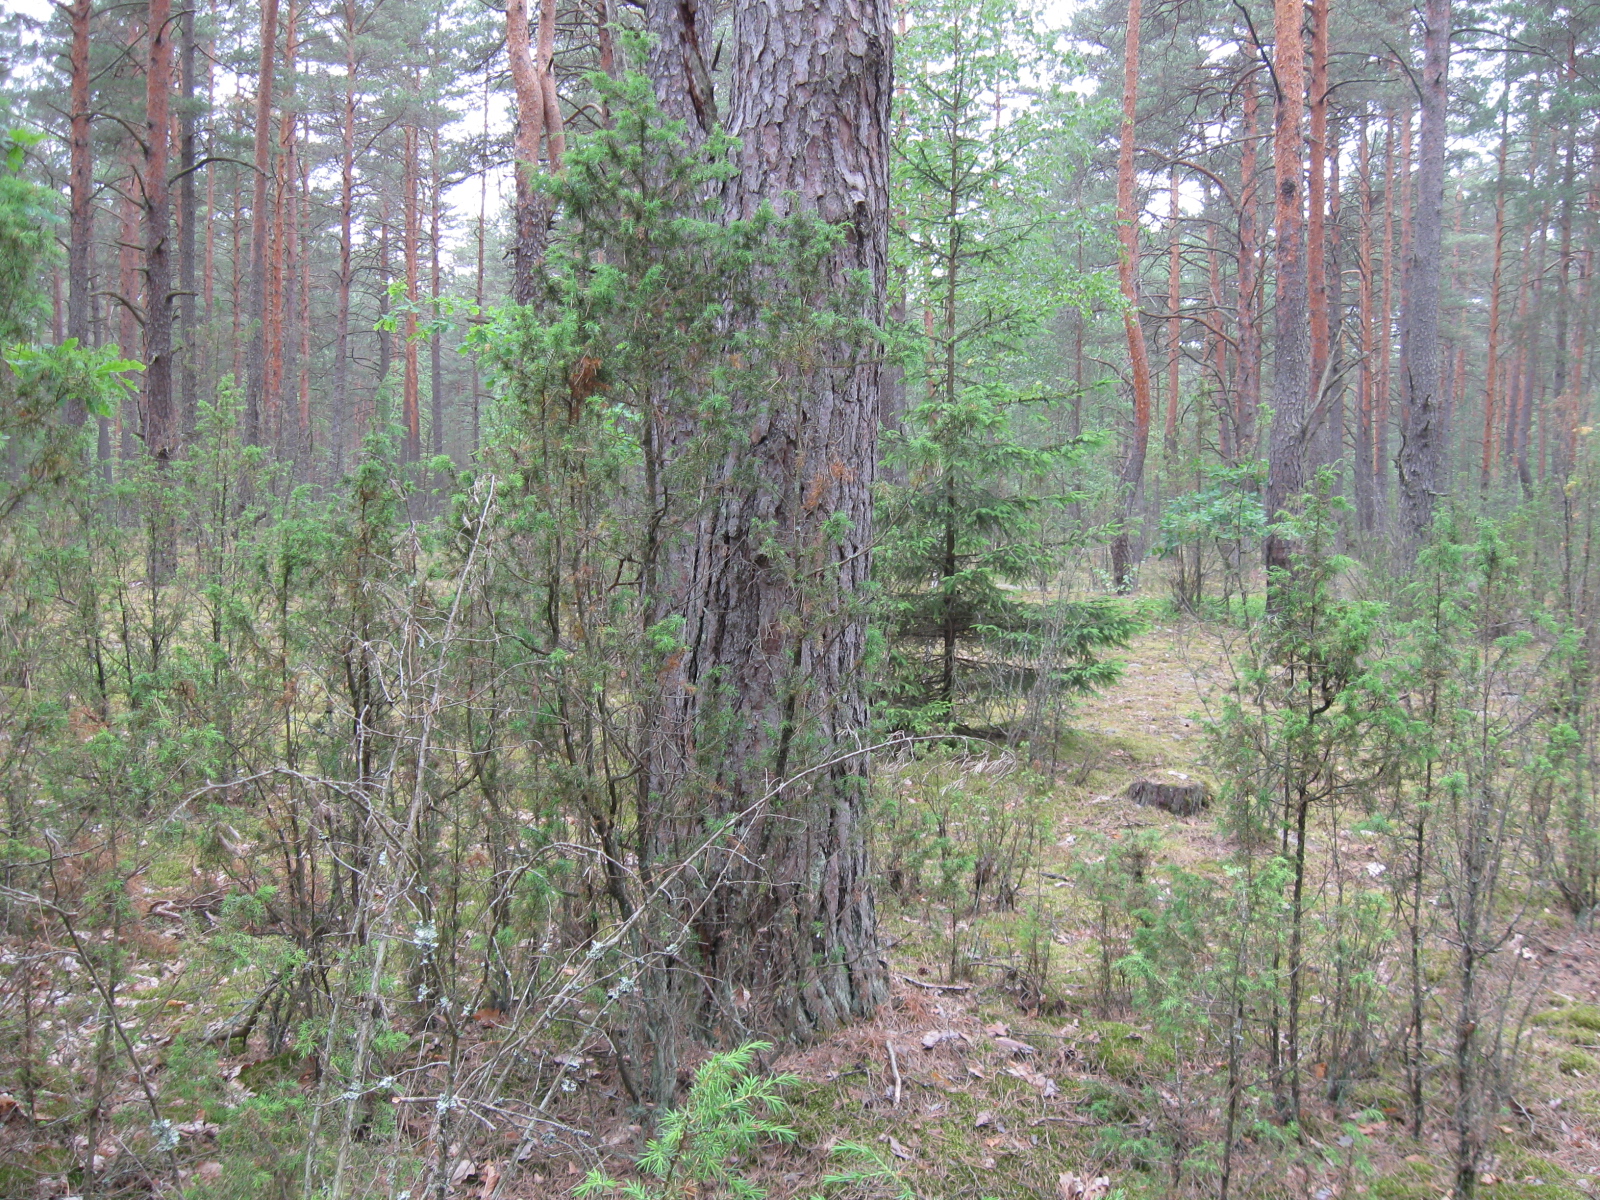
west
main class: Woodland
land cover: Pine dominated coniferous woodland
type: hemiboreal forest and nemoral coniferous forest and mixed broadleaved-coniferous forest
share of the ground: > 75 %
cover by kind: coniferous forest trees 80 %, broadleaved forest trees 15 %, lichens and mosses 5 %
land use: Forestry
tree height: > 5 m
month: July
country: LT
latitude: 54.1212
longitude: 24.2822
